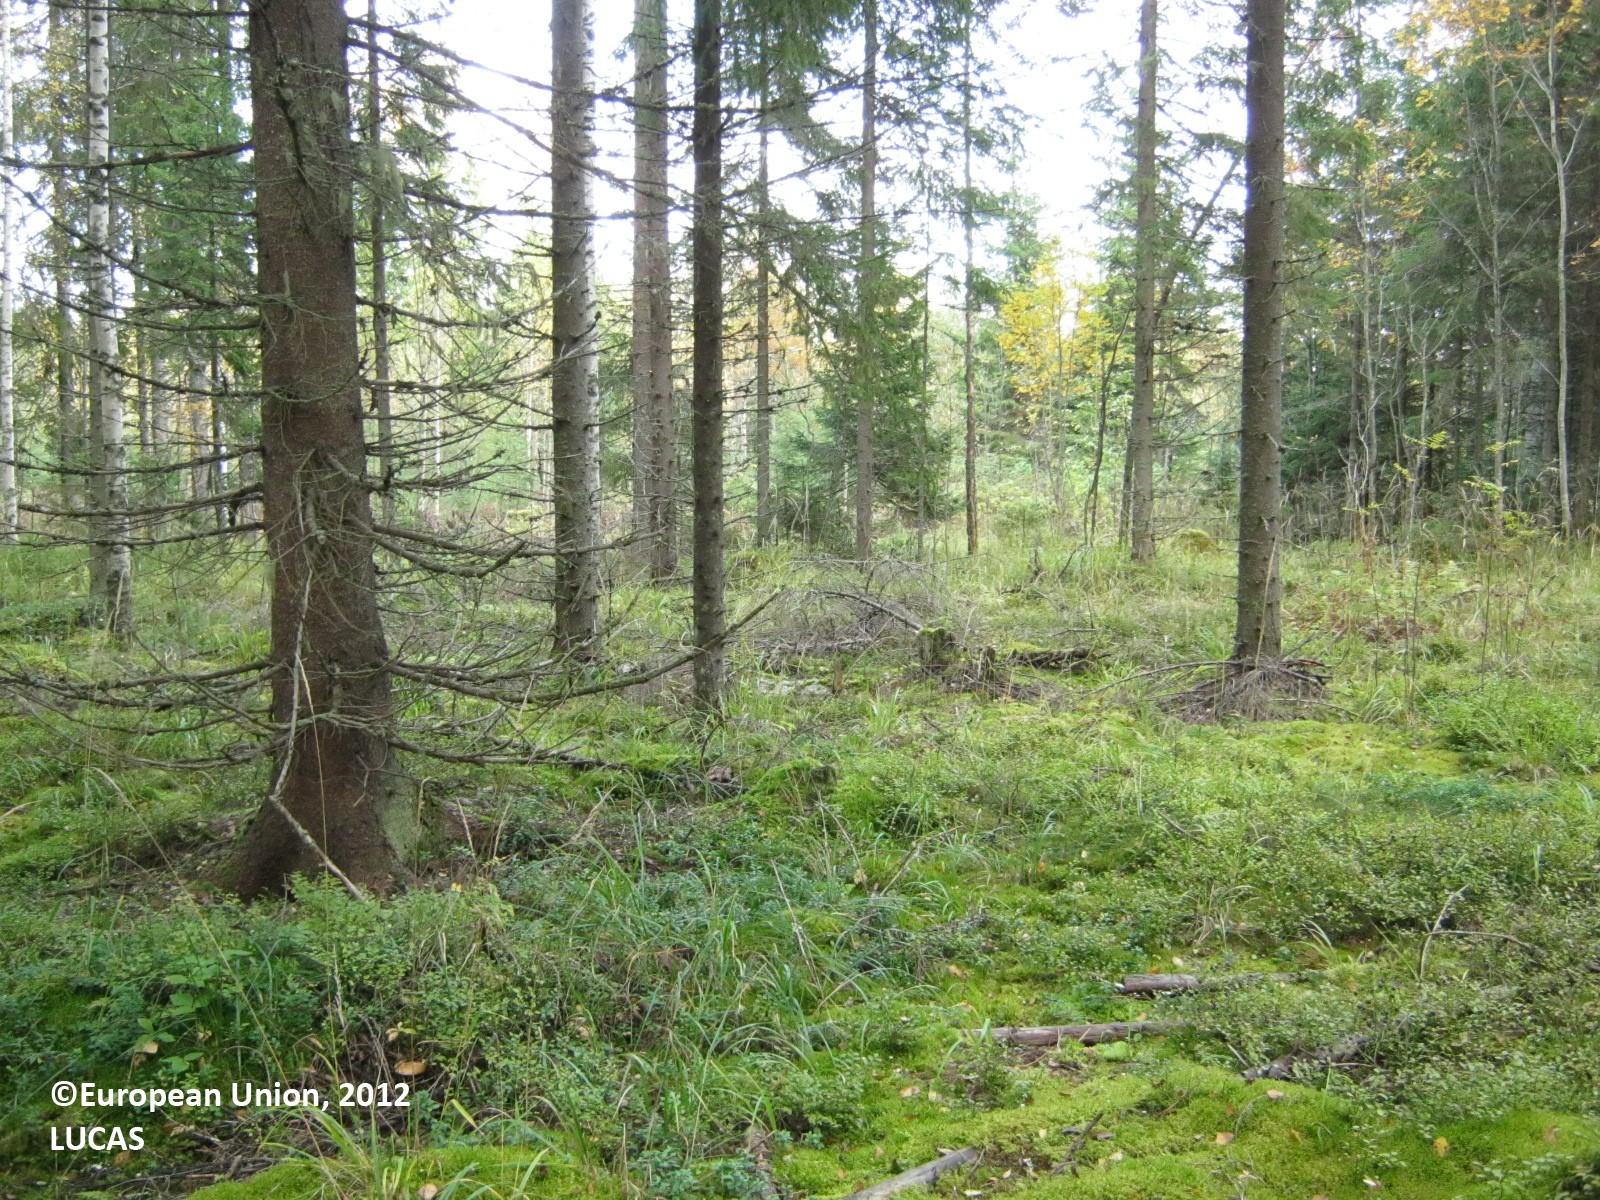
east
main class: Woodland
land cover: Spruce dominated coniferous woodland
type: boreal forest
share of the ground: 50 - 75 %
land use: Forestry
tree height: > 5 m
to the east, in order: Spruce dominated coniferous woodland; Spruce dominated mixed woodland; Ditches and canals; Tracks; Ditches and canals; Other mixed woodland; Ditches and canals; Other mixed woodland; Ditches and canals; Other mixed woodland; Spruce dominated coniferous woodland; Broadleaved woodland
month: September
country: FI
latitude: 62.4050
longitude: 28.8905
